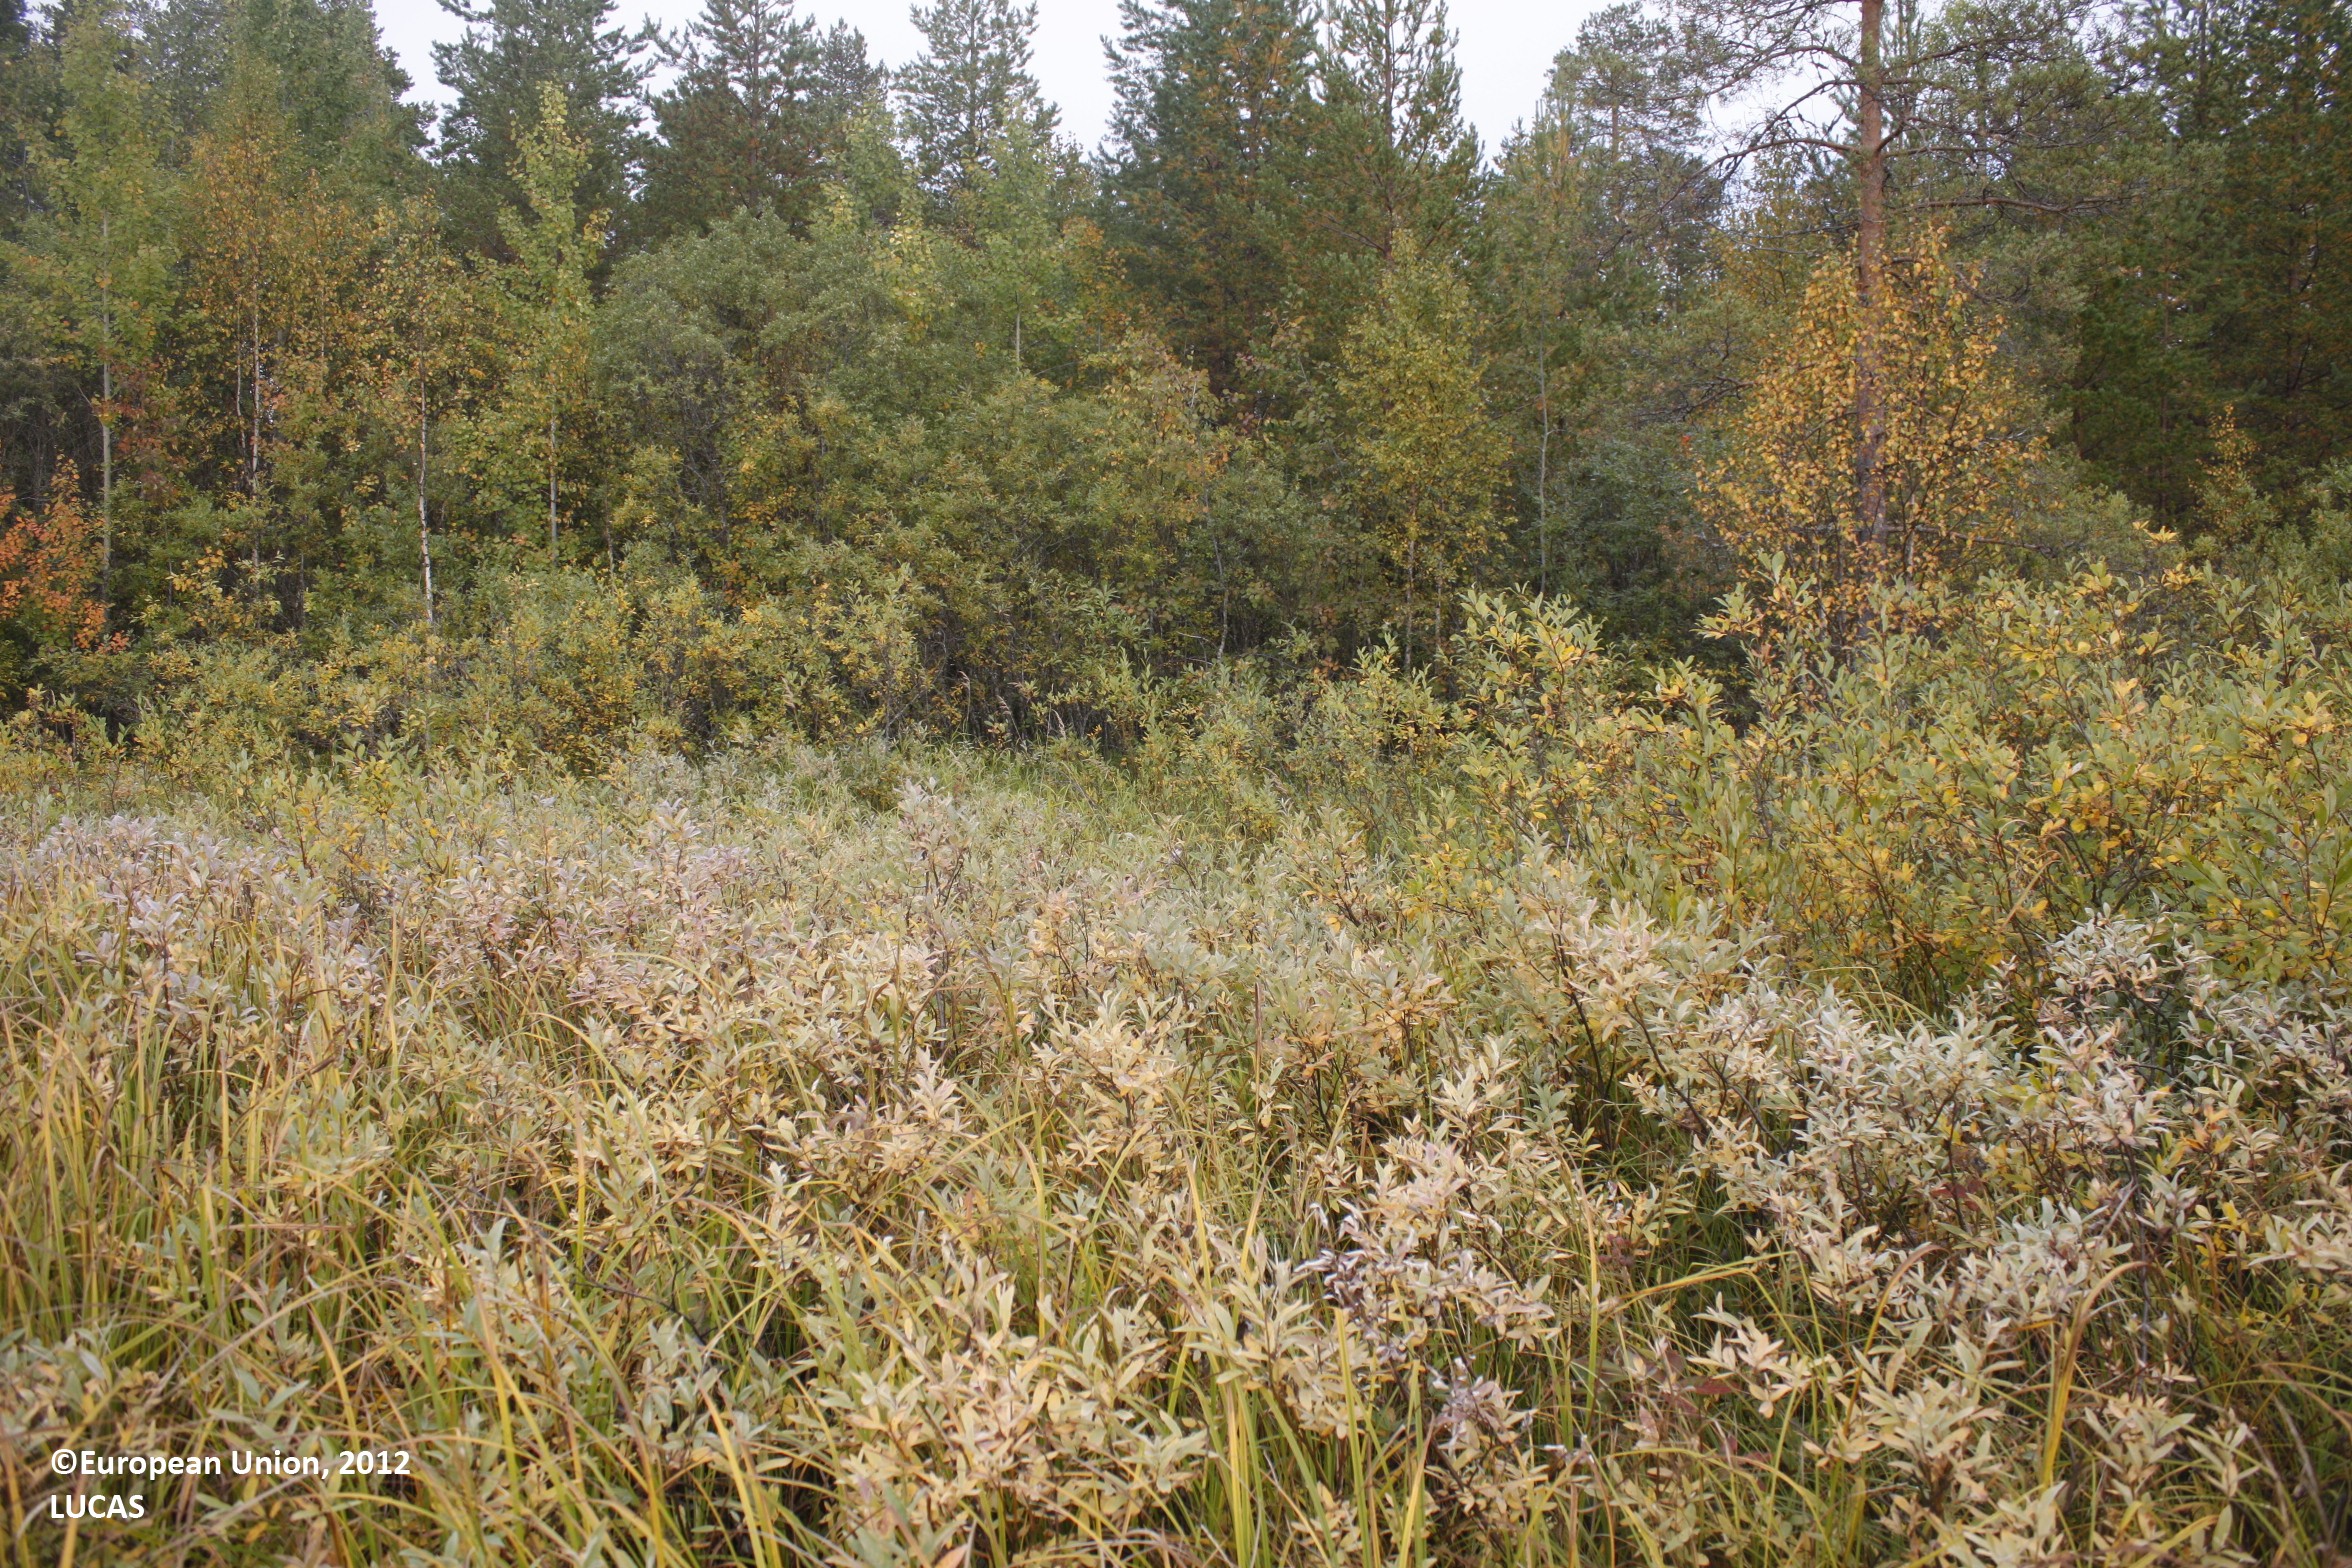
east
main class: Woodland
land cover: Pine dominated mixed woodland
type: mire and swamp forests
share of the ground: 50 - 75 %
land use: Forestry
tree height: > 5 m
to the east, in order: Pine dominated mixed woodland; Shrubland with sparse tree cover; Inland water bodies; Inland marshes; Pine dominated mixed woodland; Electric lines; Pine dominated coniferous woodland; Ditches and canals; Tracks; Ditches and canals; Electric lines; Shrubland with sparse tree cover
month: September
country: FI
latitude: 65.3144
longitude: 26.9617
